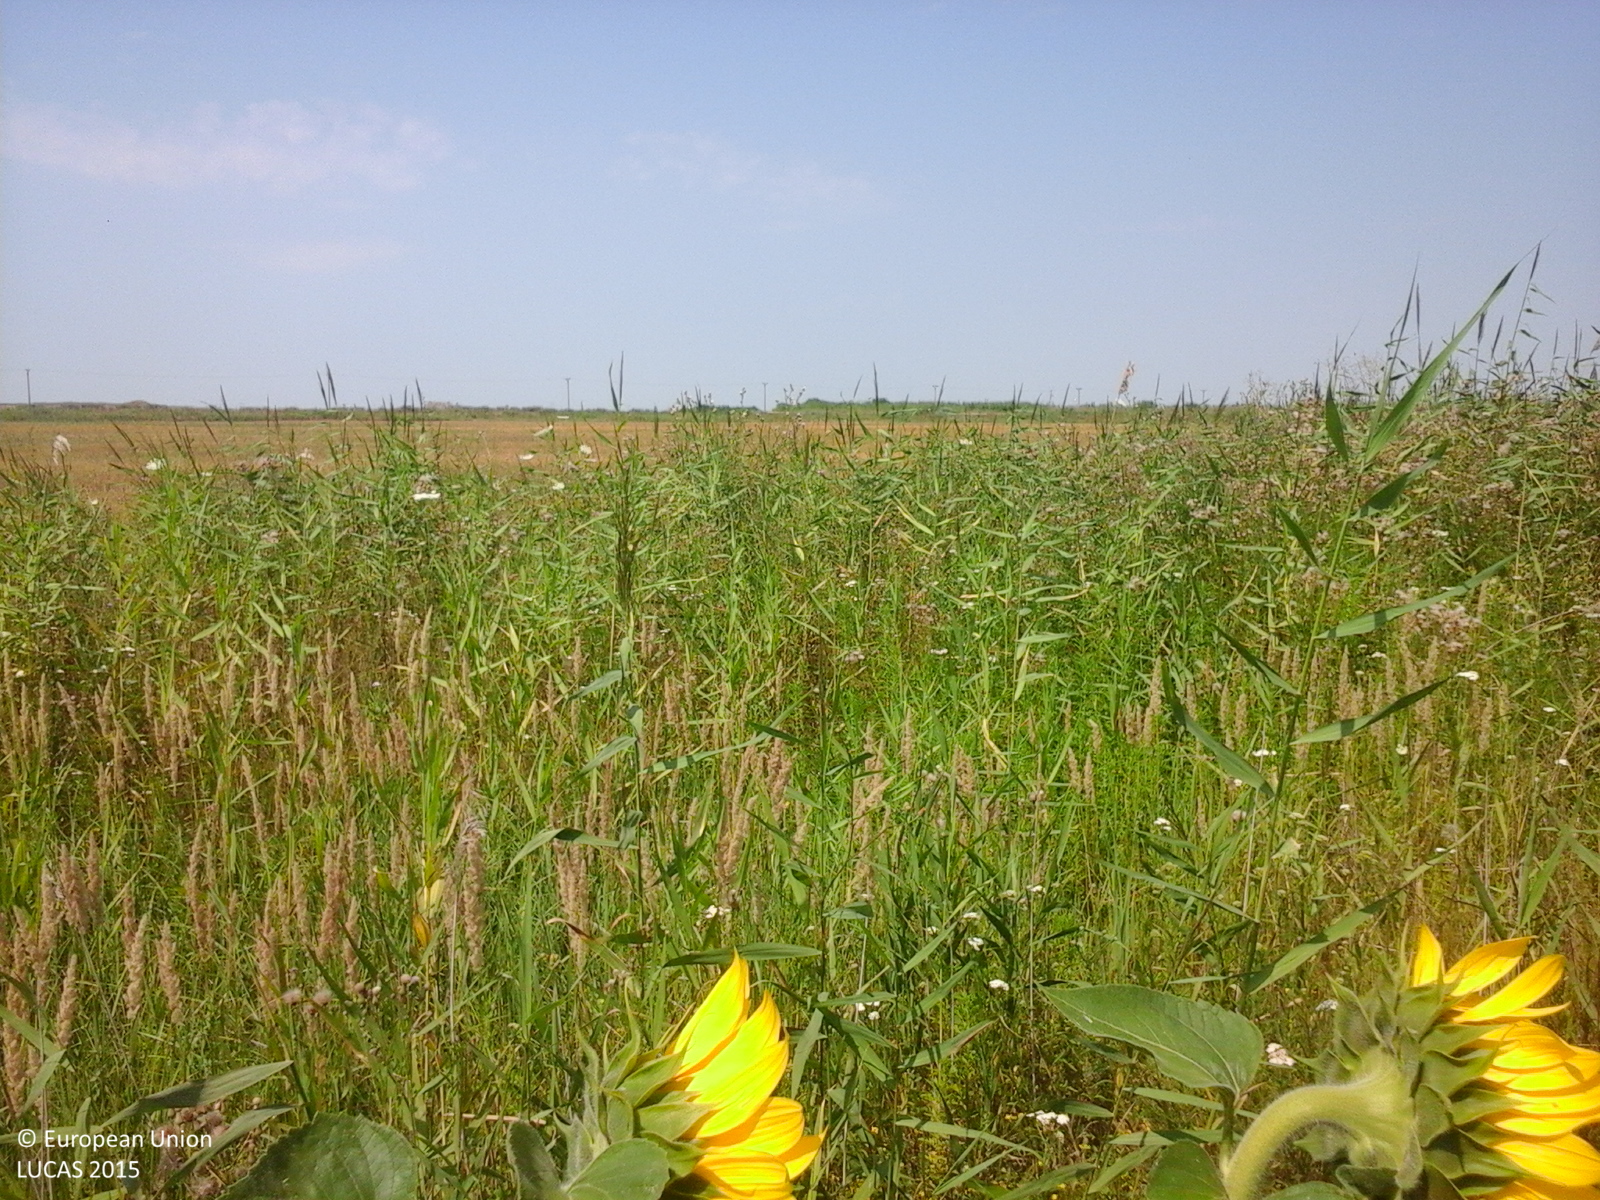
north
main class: Cropland
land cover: Sunflower
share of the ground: > 75 %
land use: Agriculture (excluding fallow land and kitchen gardens)
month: July
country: RO
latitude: 44.6328
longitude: 27.8402
